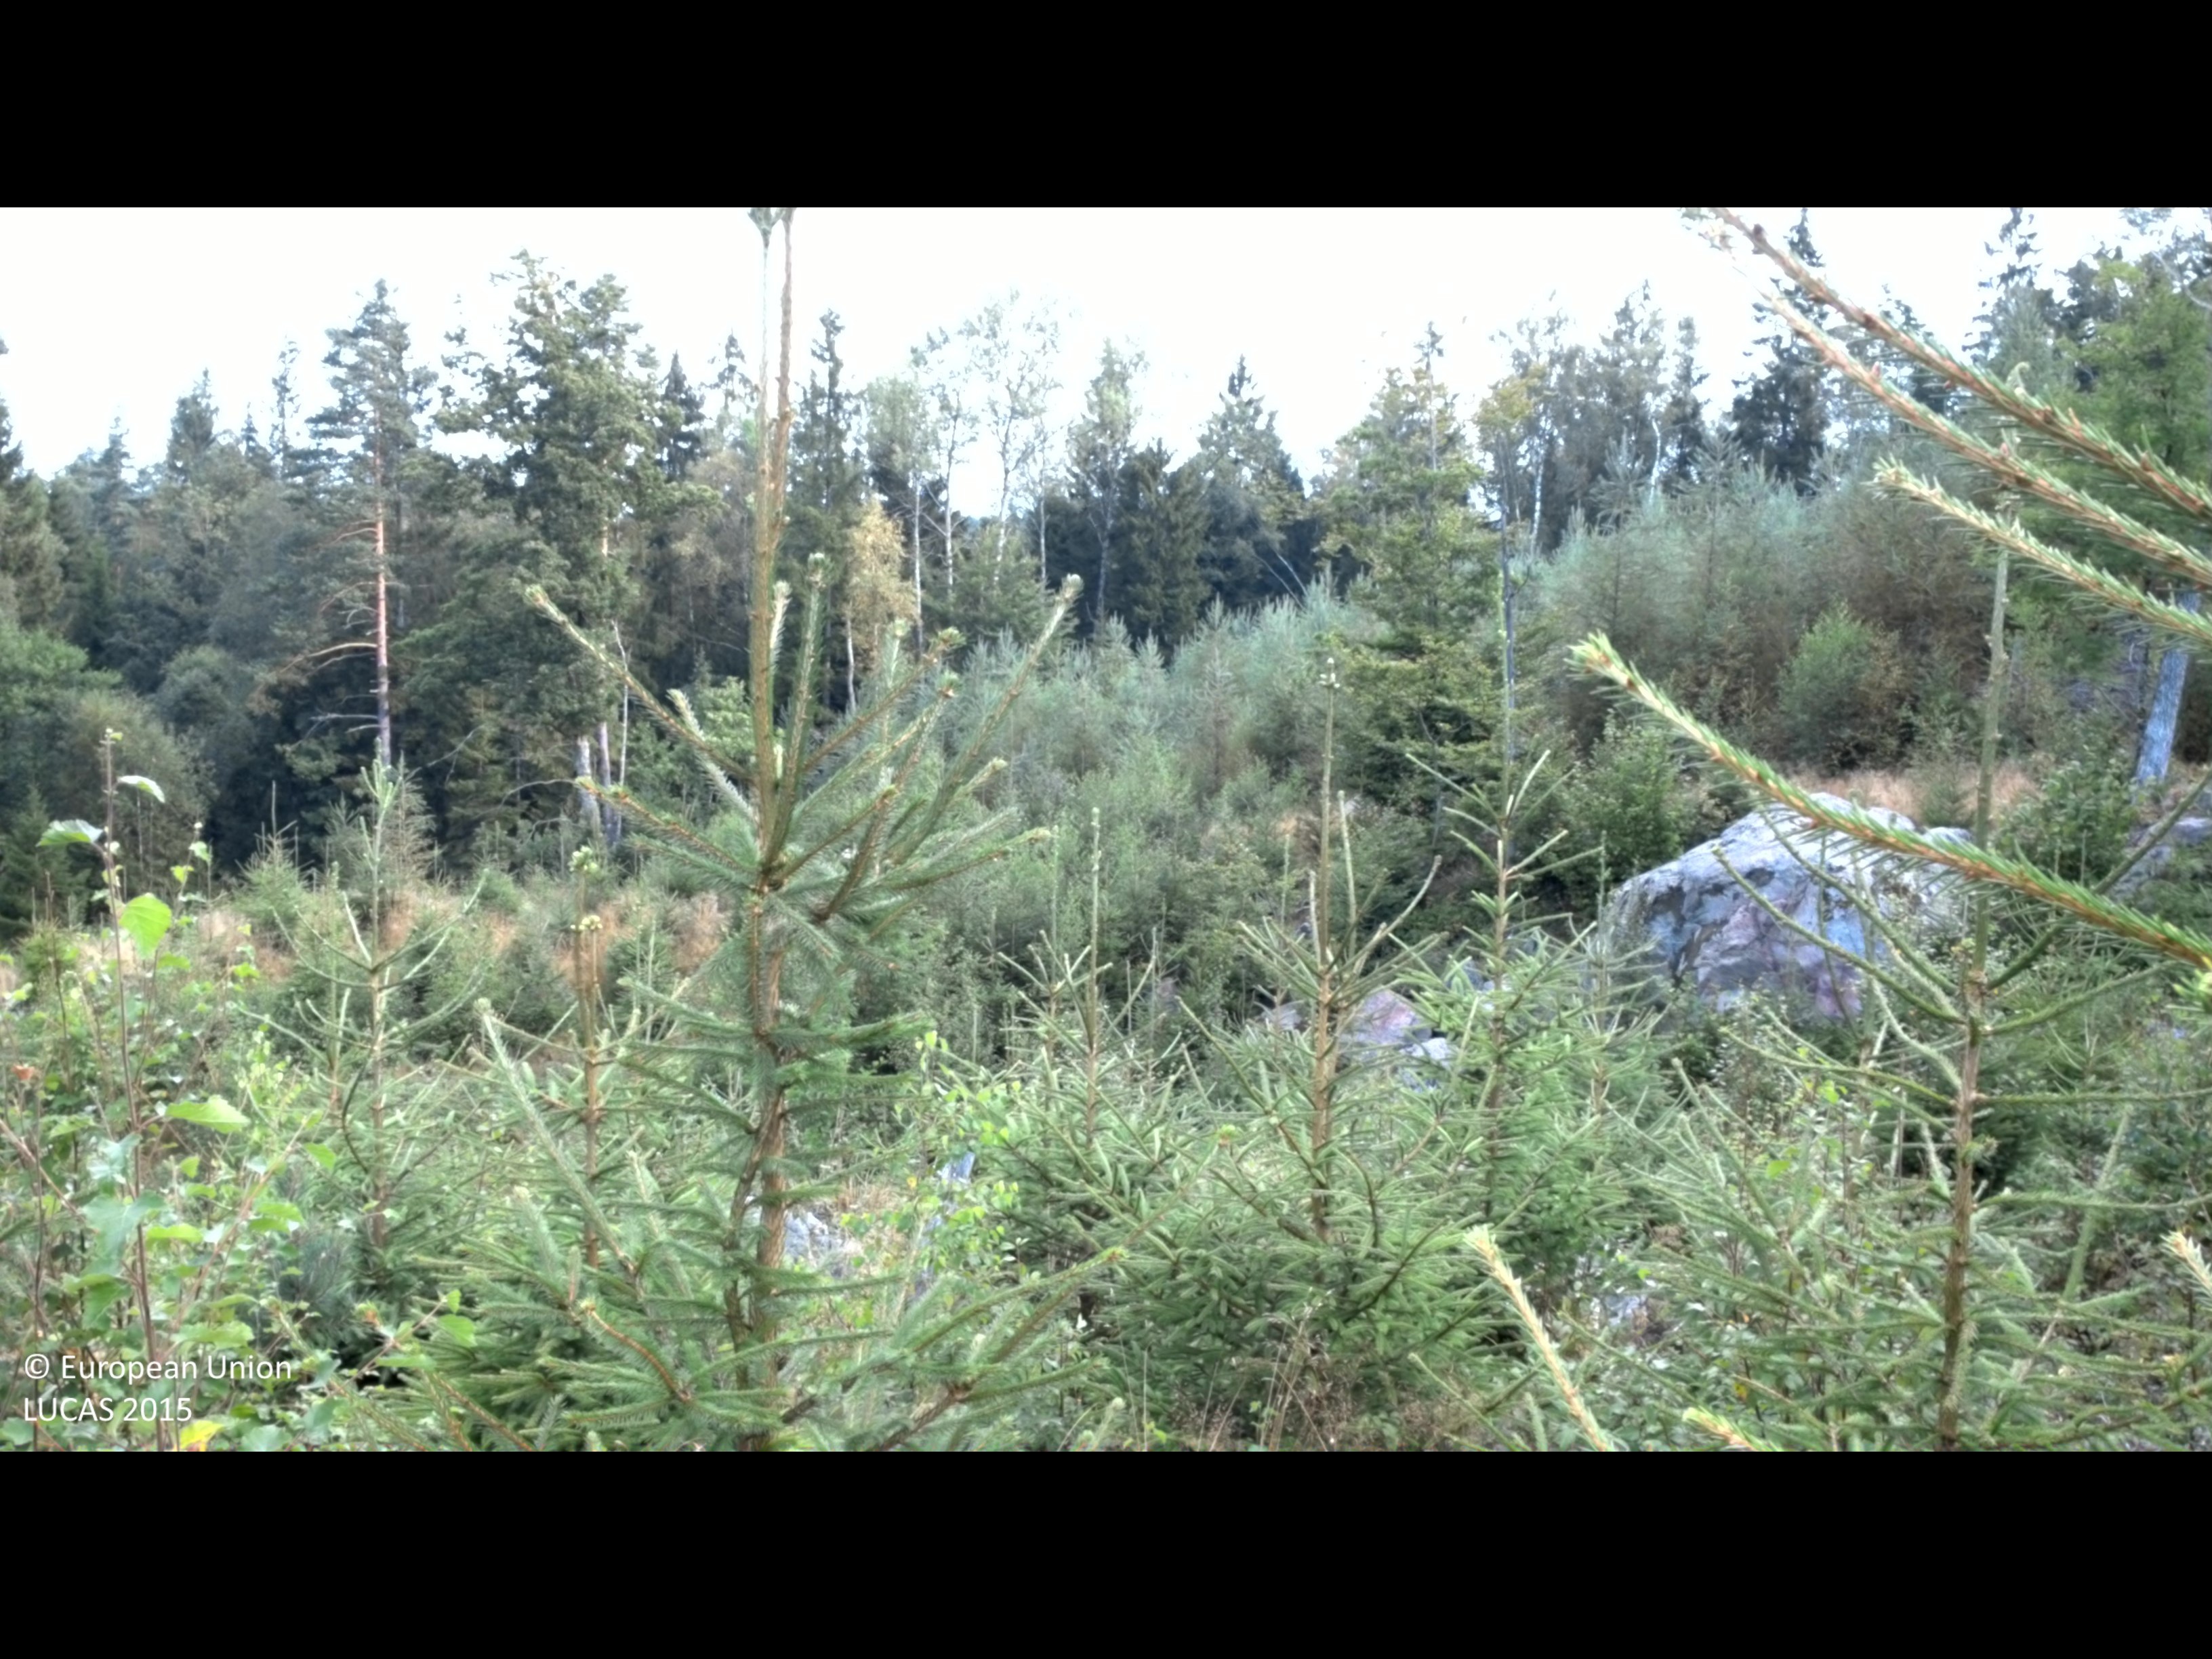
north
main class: Woodland
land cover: Spruce dominated mixed woodland
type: boreal forest
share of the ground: 50 - 75 %
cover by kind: coniferous forest trees 45 %, shrubs 30 %, broadleaved forest trees 15 %, herbaceous plants 10 %
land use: Forestry
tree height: < 5 m
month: August
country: SE
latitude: 56.7951
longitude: 13.2221
